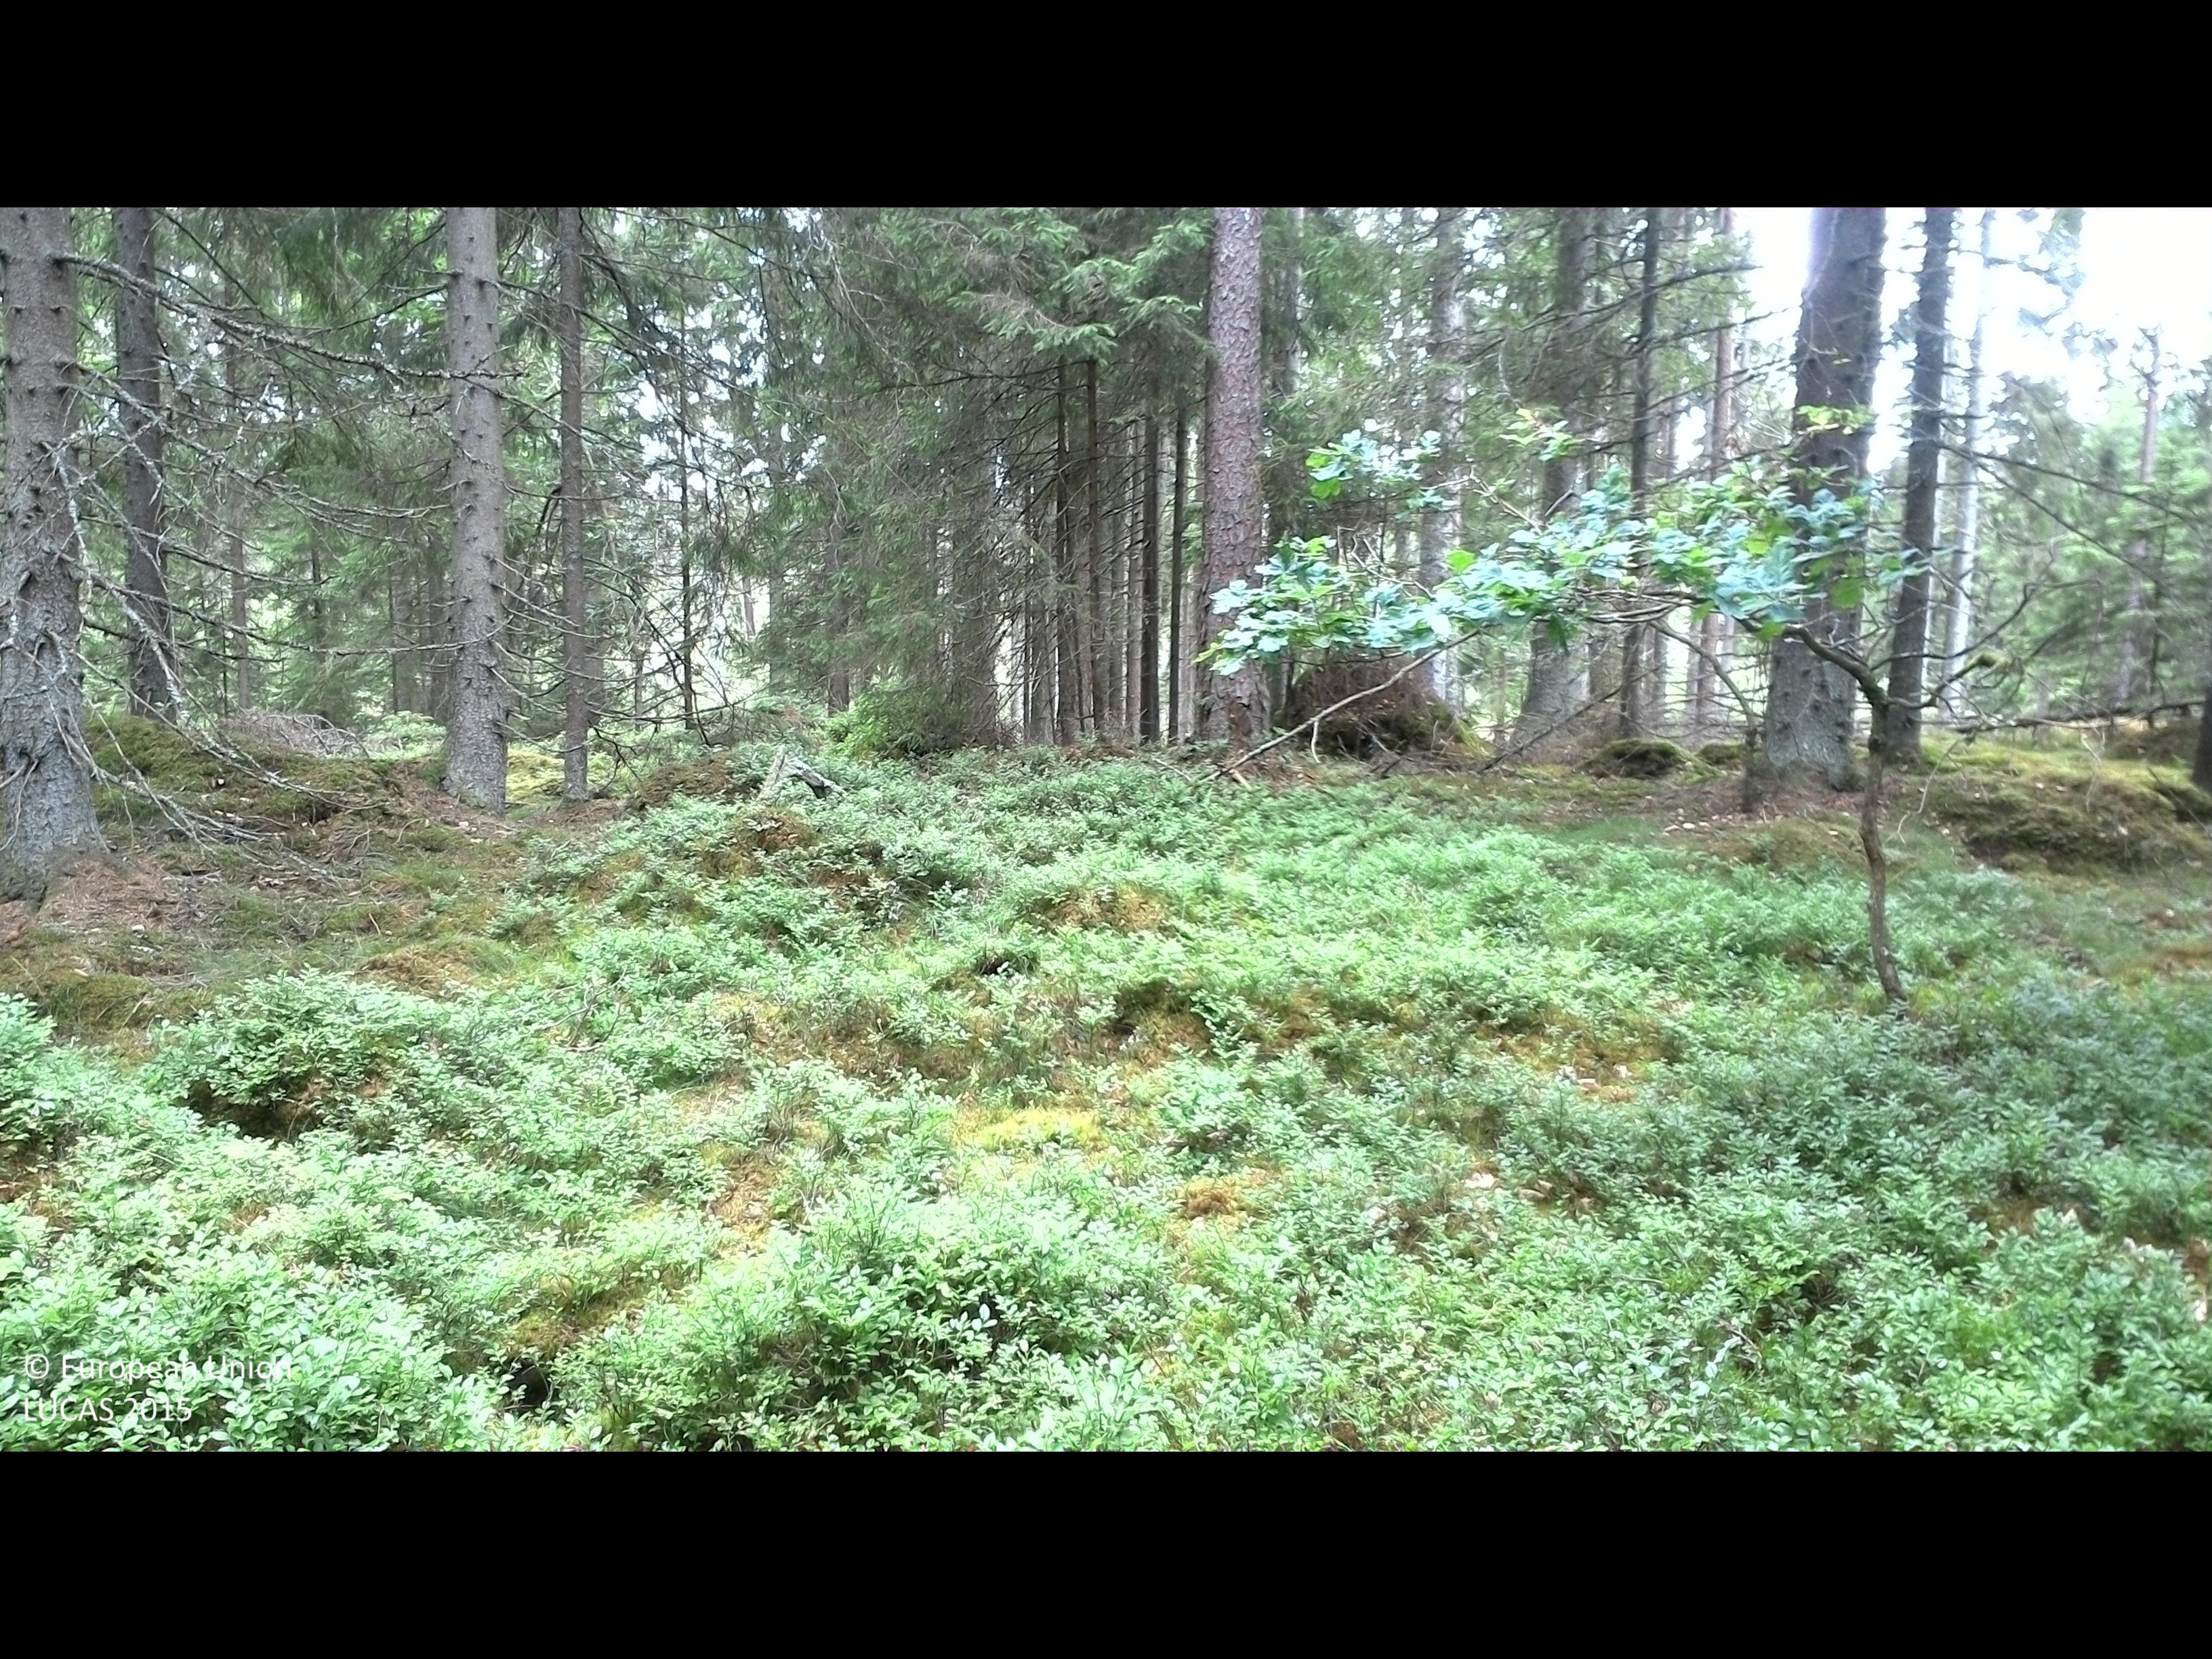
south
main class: Woodland
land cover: Spruce dominated coniferous woodland
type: boreal forest
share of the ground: > 75 %
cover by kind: coniferous forest trees 75 %, lichens and mosses 15 %, shrubs 10 %
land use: Forestry
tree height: > 5 m
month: July
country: SE
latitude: 56.4792
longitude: 14.7226
